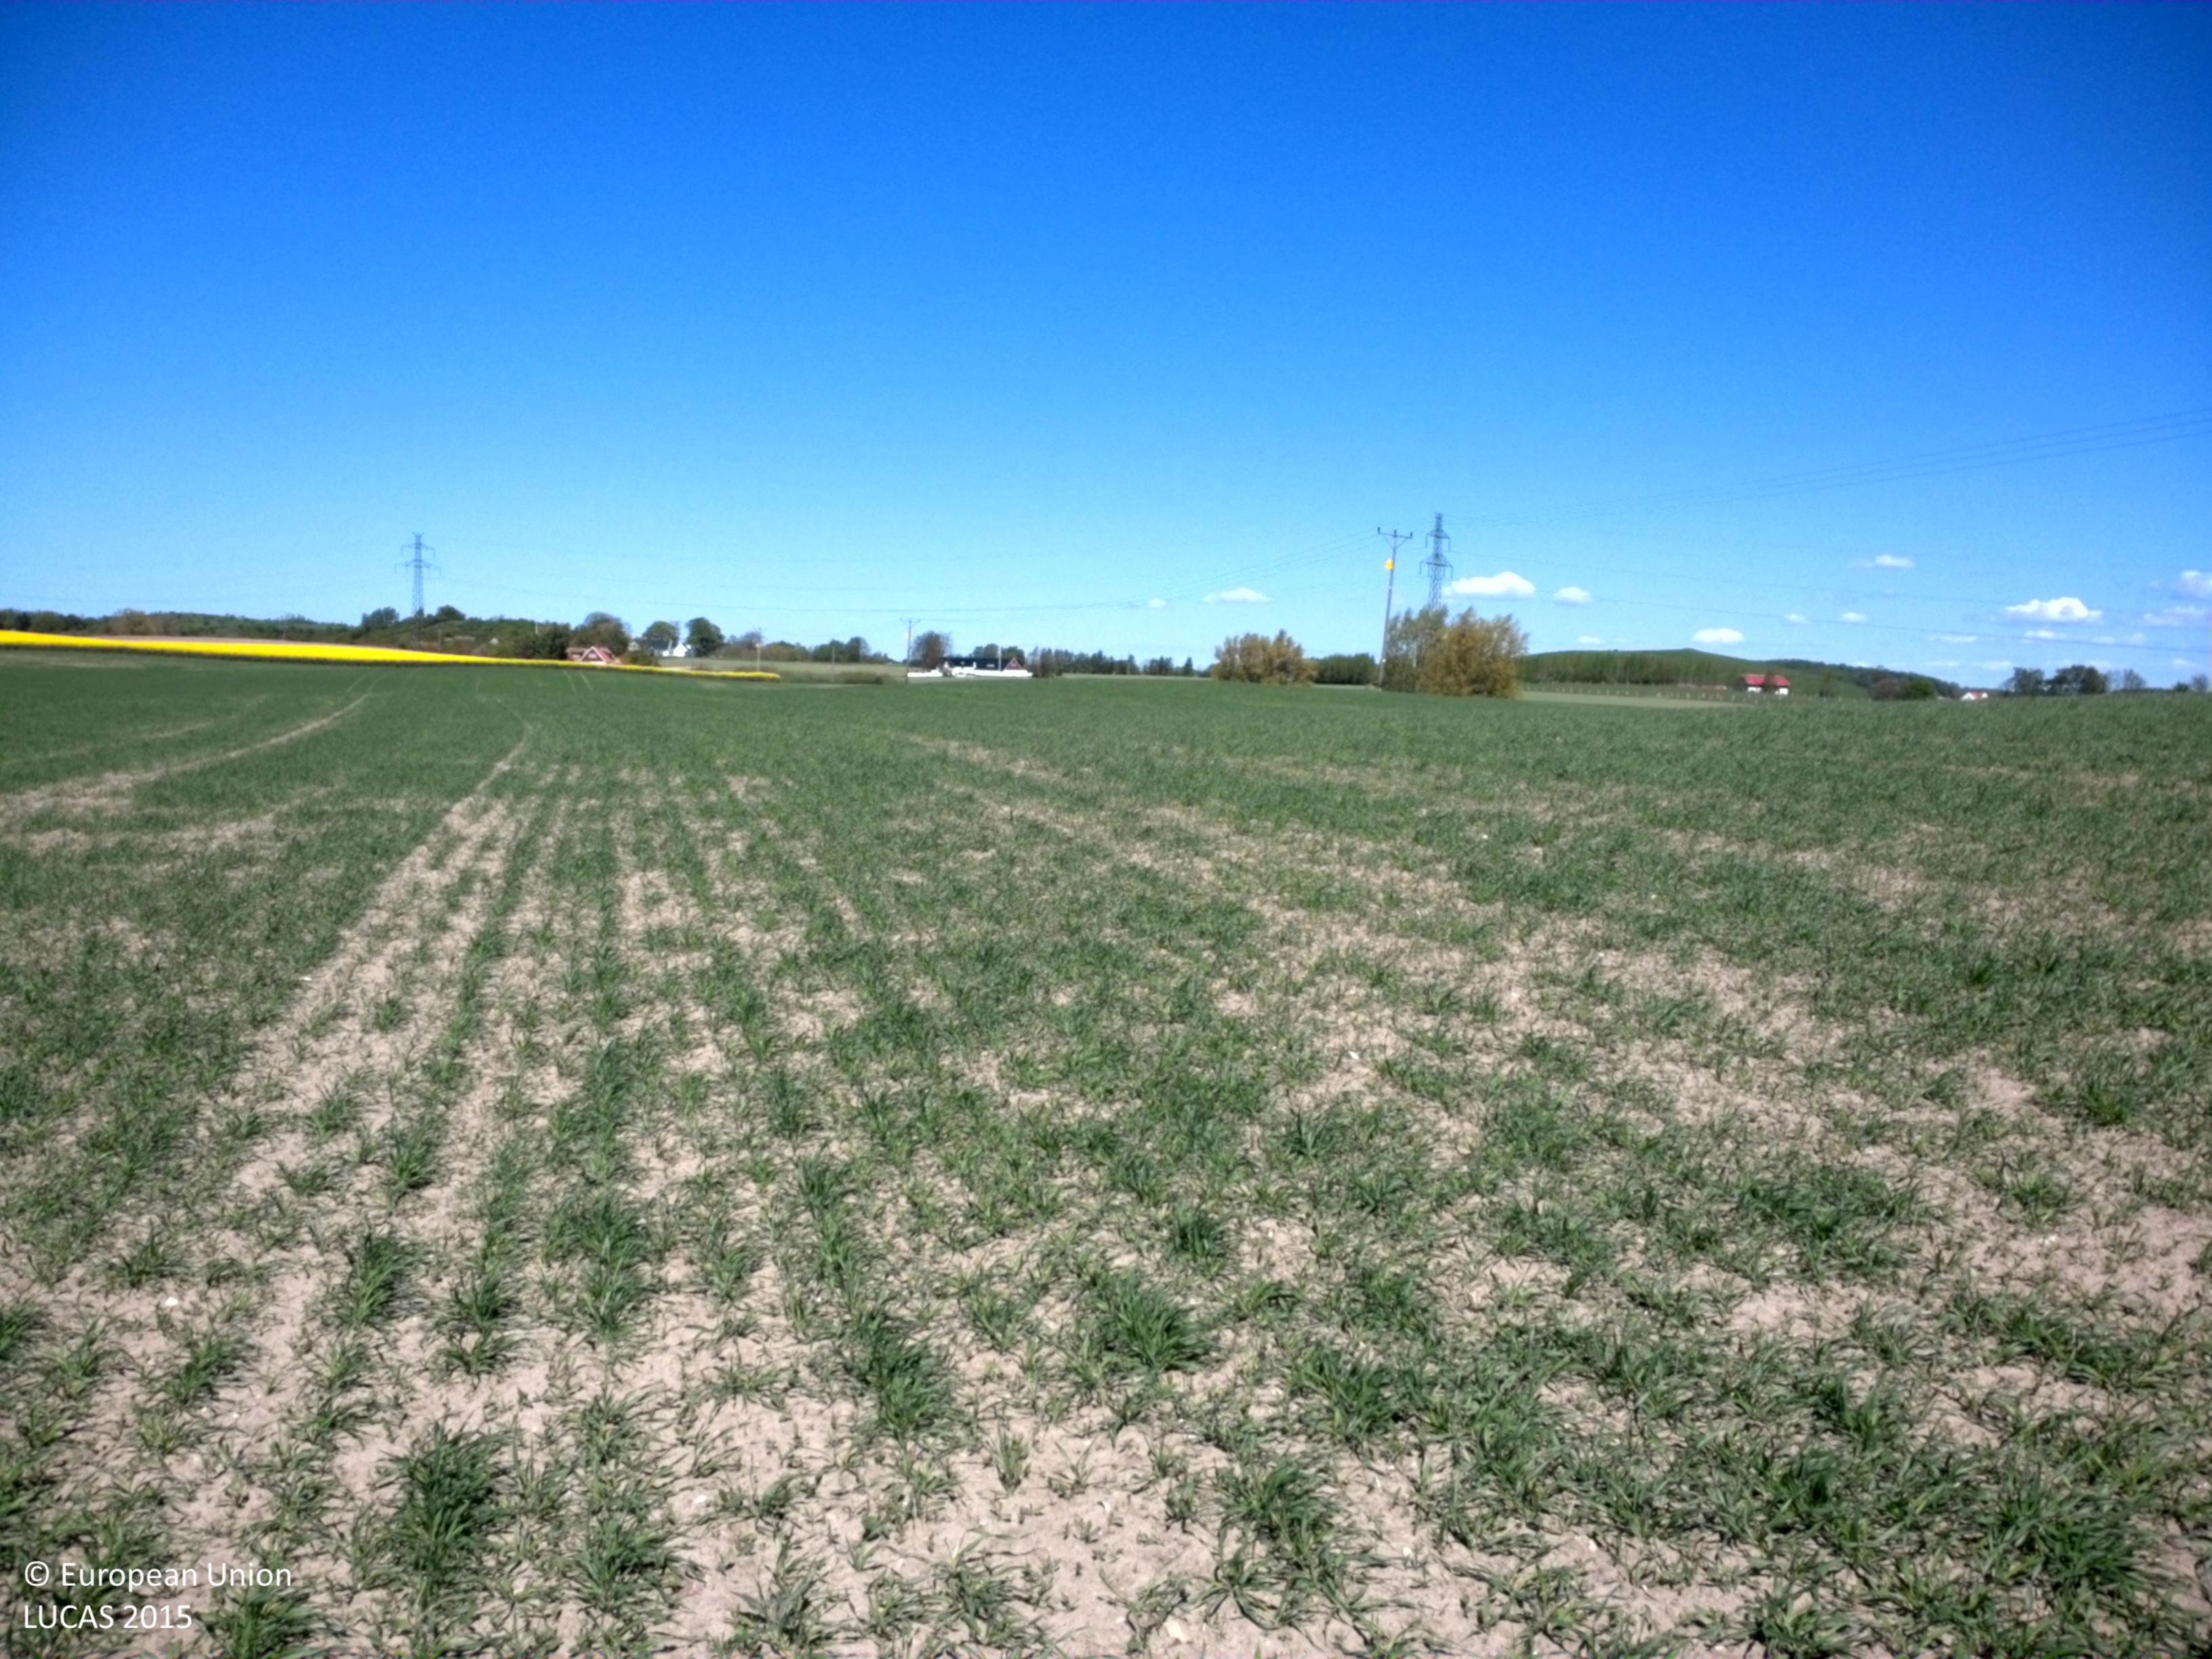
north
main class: Cropland
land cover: Barley
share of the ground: 50 - 75 %
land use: Agriculture (excluding fallow land and kitchen gardens)
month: May
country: SE
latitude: 55.5023
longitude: 13.1169
